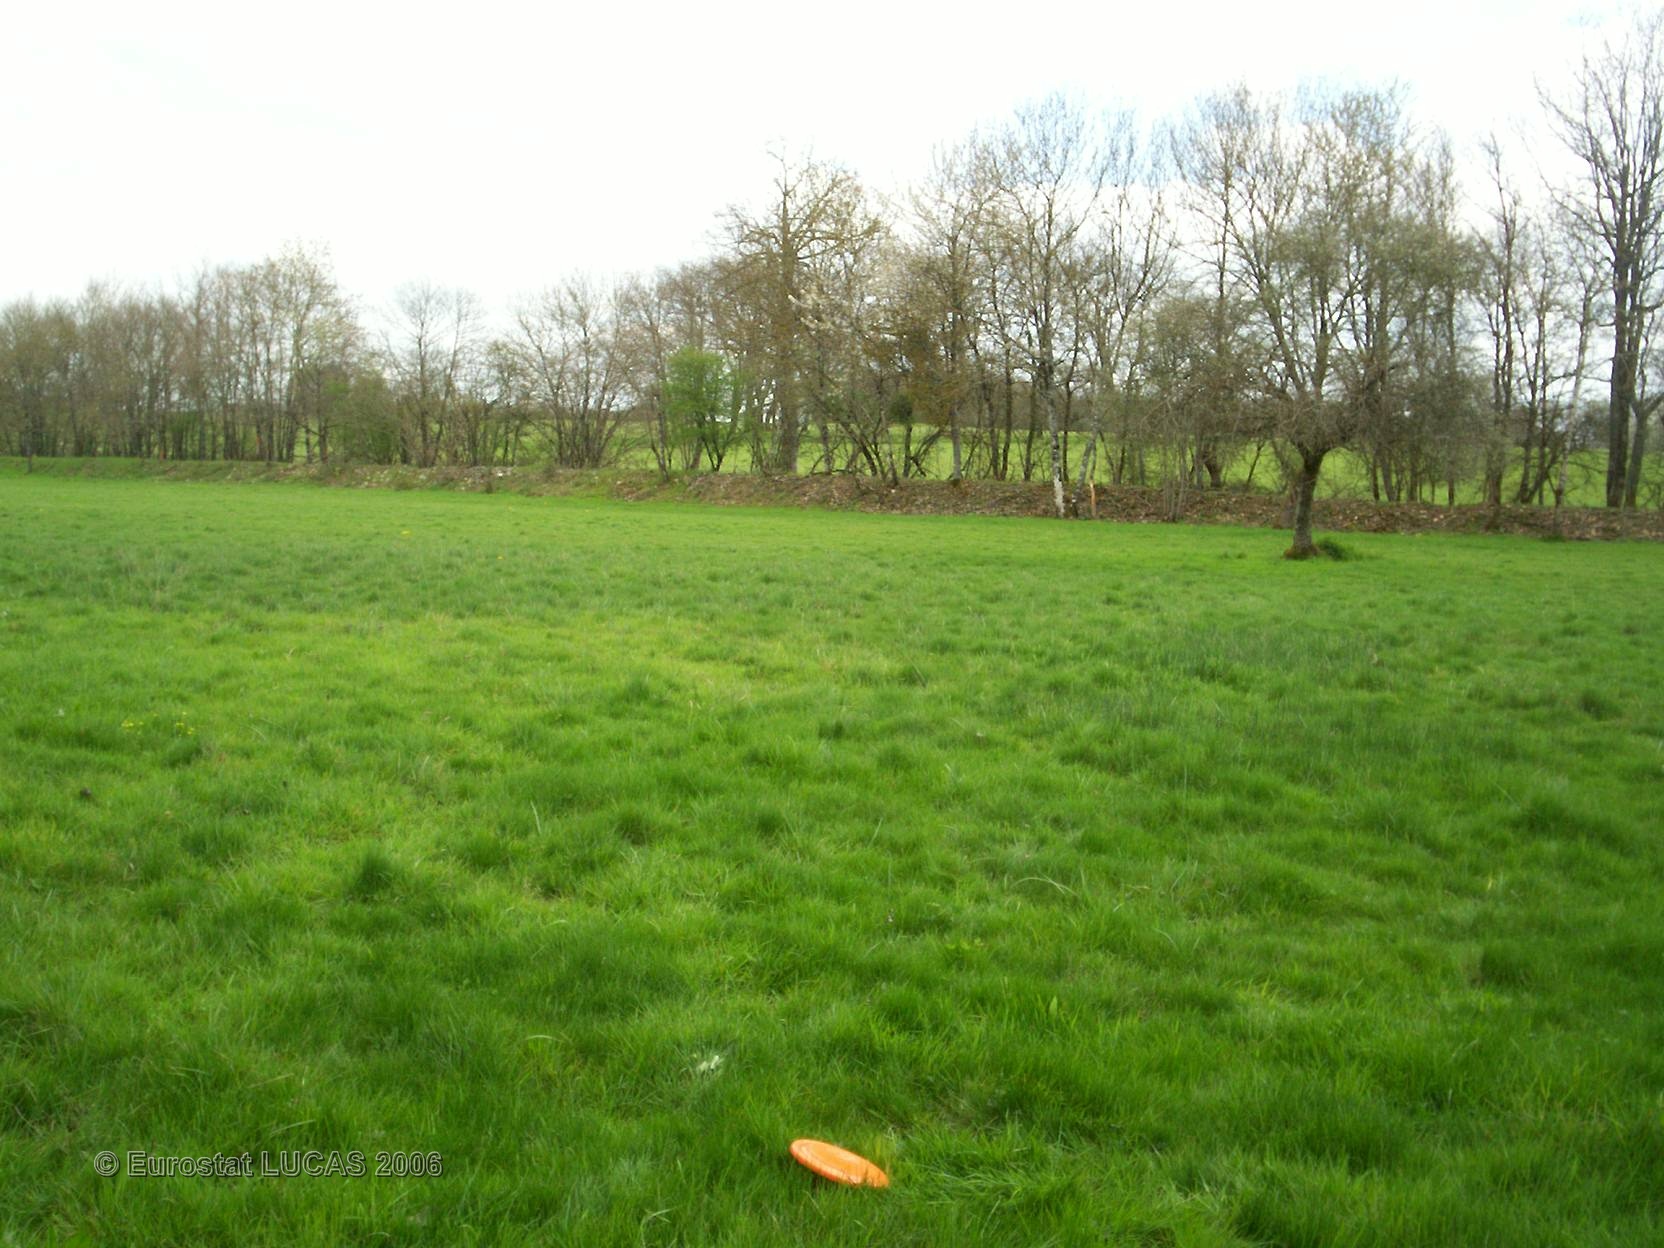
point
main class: Grassland
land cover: Grassland without tree/shrub cover
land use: Agriculture (excluding fallow land and kitchen gardens)
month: April
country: FR
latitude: 46.2384
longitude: 0.5301
